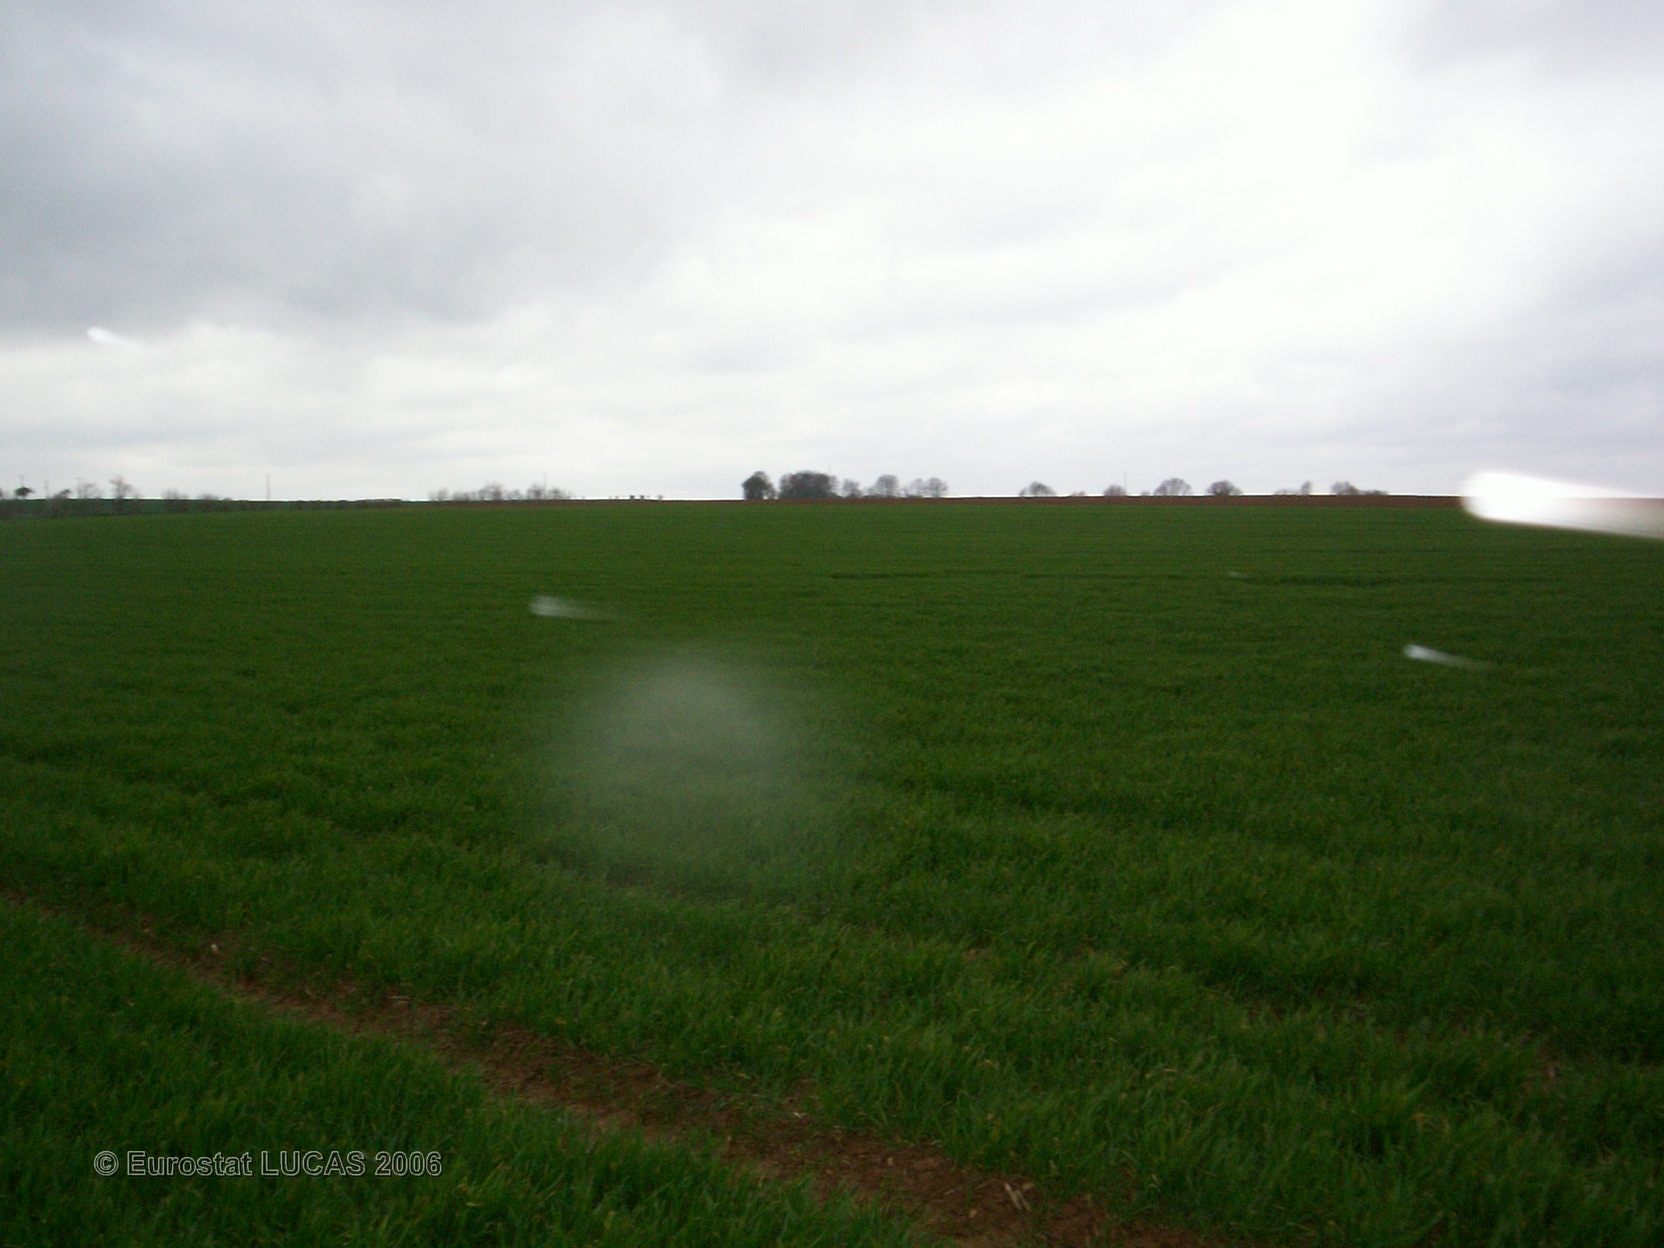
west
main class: Cropland
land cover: Common wheat
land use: Agriculture (excluding fallow land and kitchen gardens)
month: April
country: FR
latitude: 48.3587
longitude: 0.3241
